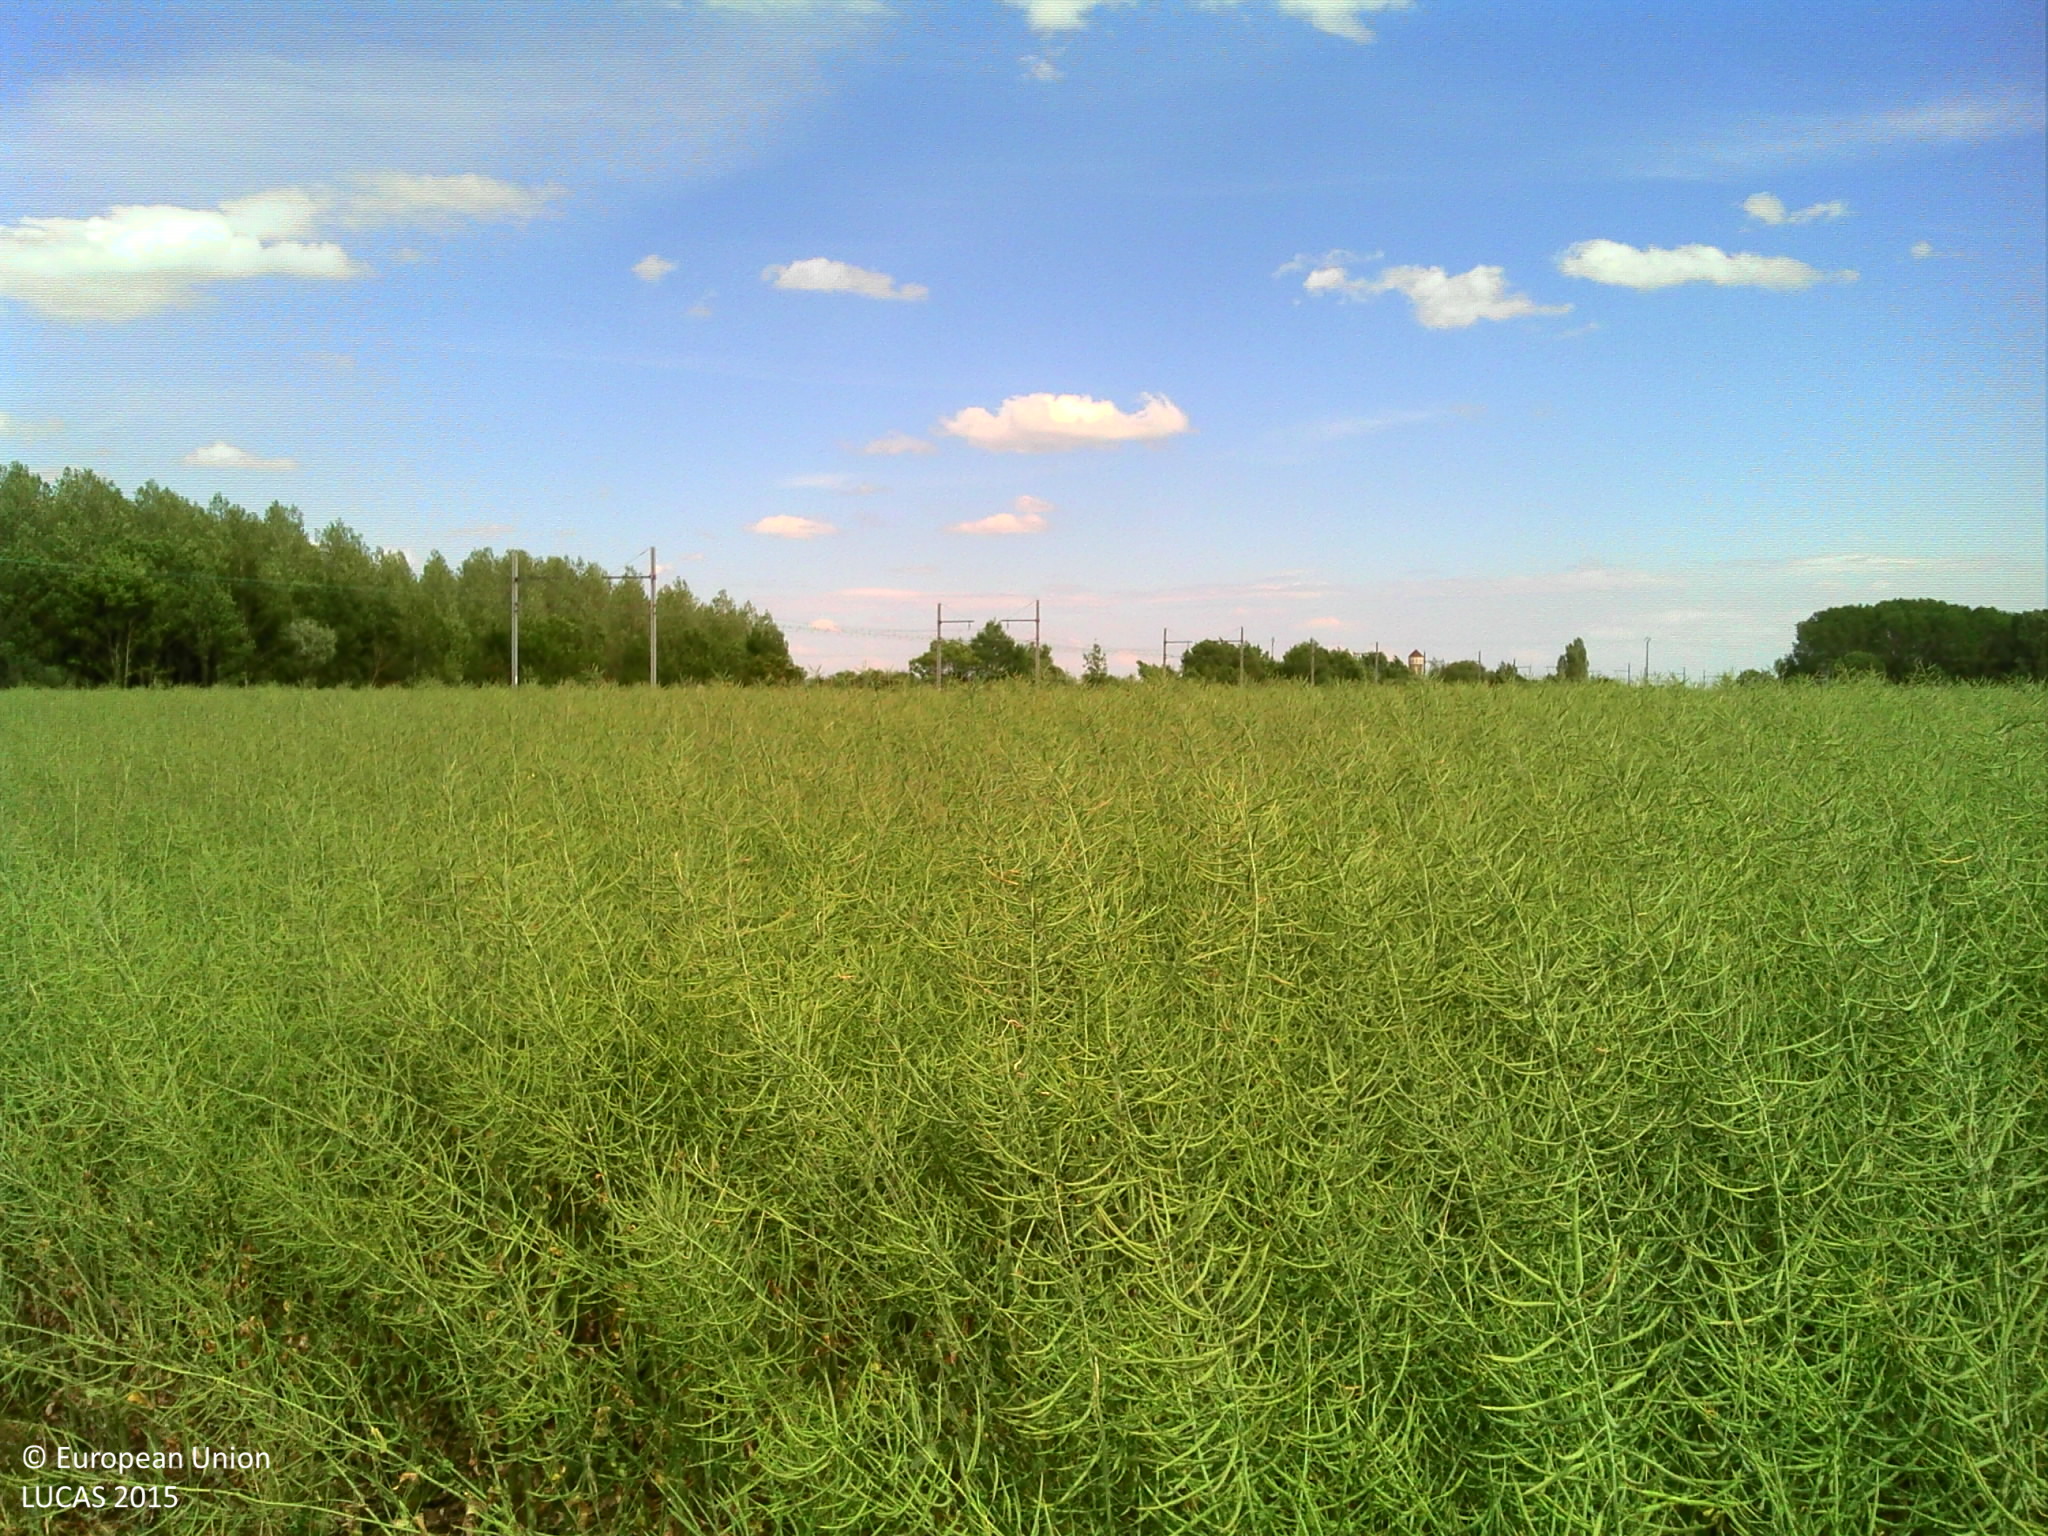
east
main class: Cropland
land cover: Rape and turnip rape
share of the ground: > 75 %
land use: Agriculture (excluding fallow land and kitchen gardens)
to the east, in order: Rape and turnip rape; Grass margins; Tracks; Grass margins; Electric lines; Railways; Electric lines; Spontaneously vegetated surfaces; Lines of trees; Managed hedges; Lines of trees; Ditches and canals; Grass margins; Rape and turnip rape
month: May
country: FR
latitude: 47.2538
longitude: 5.2043
